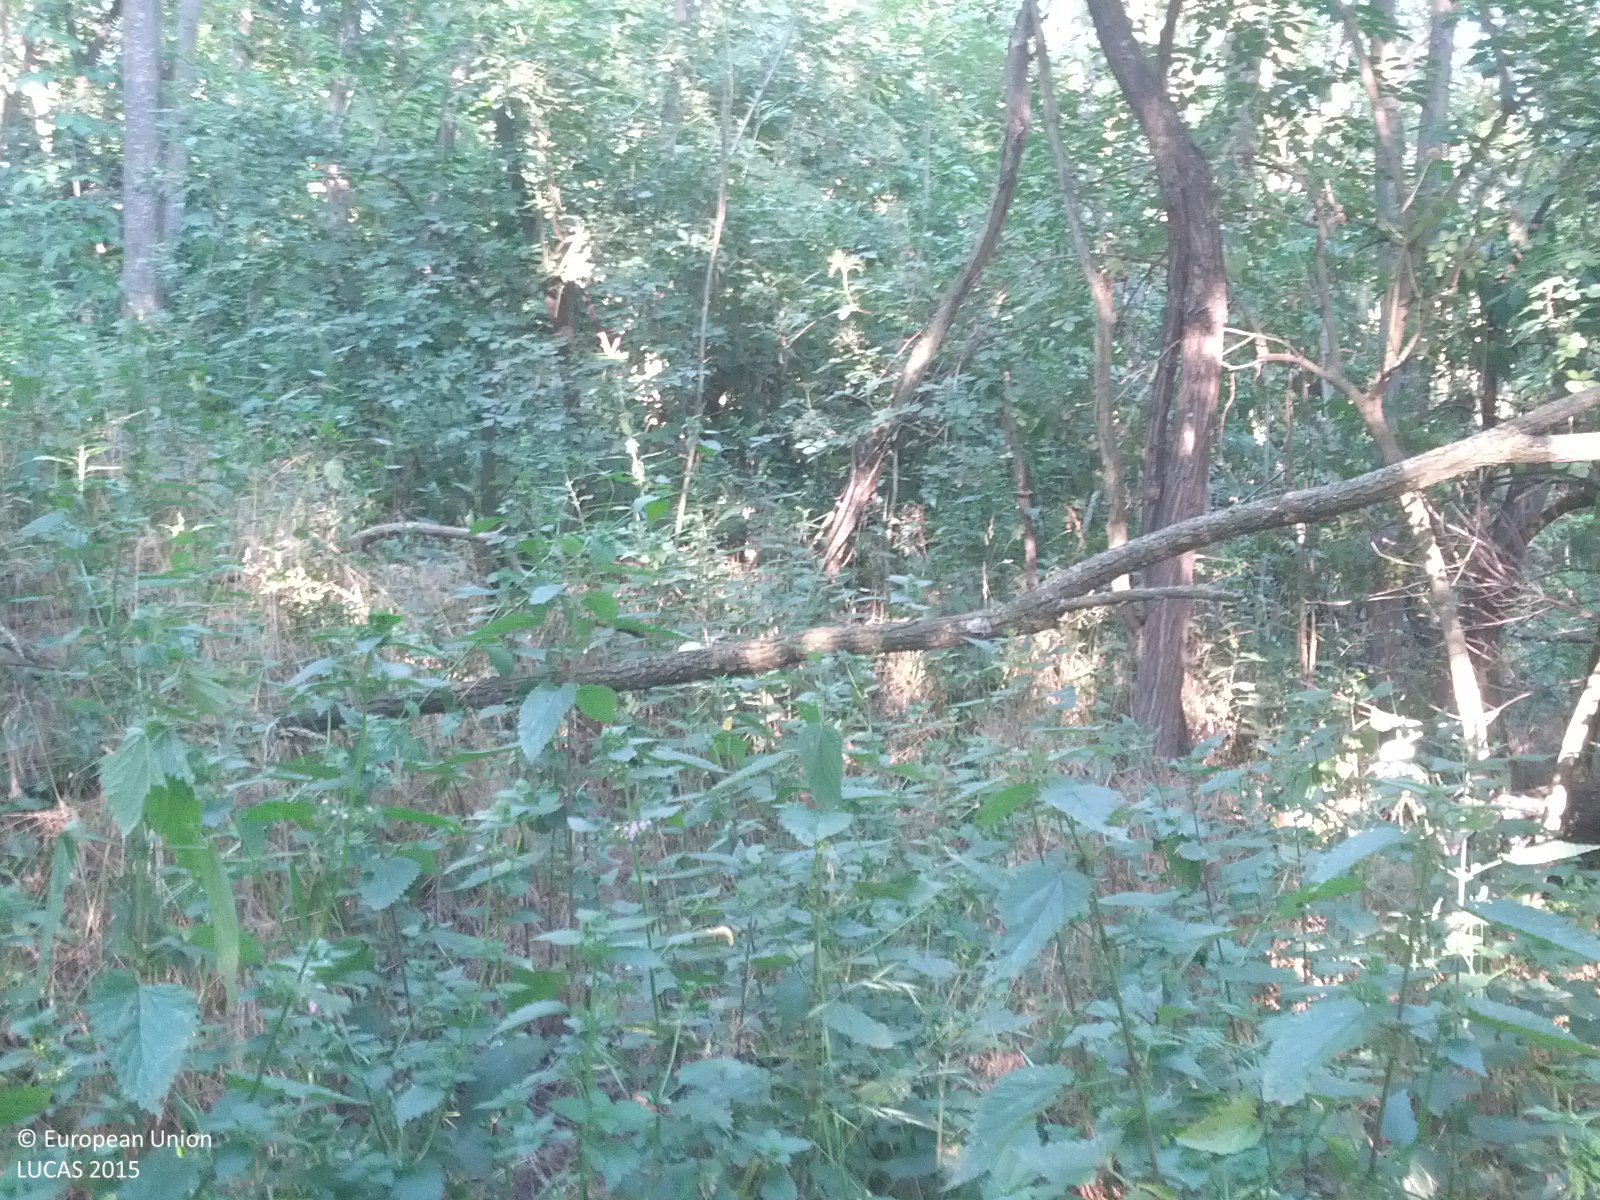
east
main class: Woodland
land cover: Broadleaved woodland
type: mesophytic deciduous forest
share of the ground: > 75 %
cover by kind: broadleaved forest trees 90 %, herbaceous plants 10 %
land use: Forestry
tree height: > 5 m
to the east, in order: Broadleaved woodland; Grass margins; Tracks; Grass margins; Vineyards; Grassland without tree/shrub cover; Vineyards; Shrubland with sparse tree cover; Temporary grasslands; Vineyards; Barley; Grassland without tree/shrub cover
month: July
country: AT
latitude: 48.3862
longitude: 16.6095
